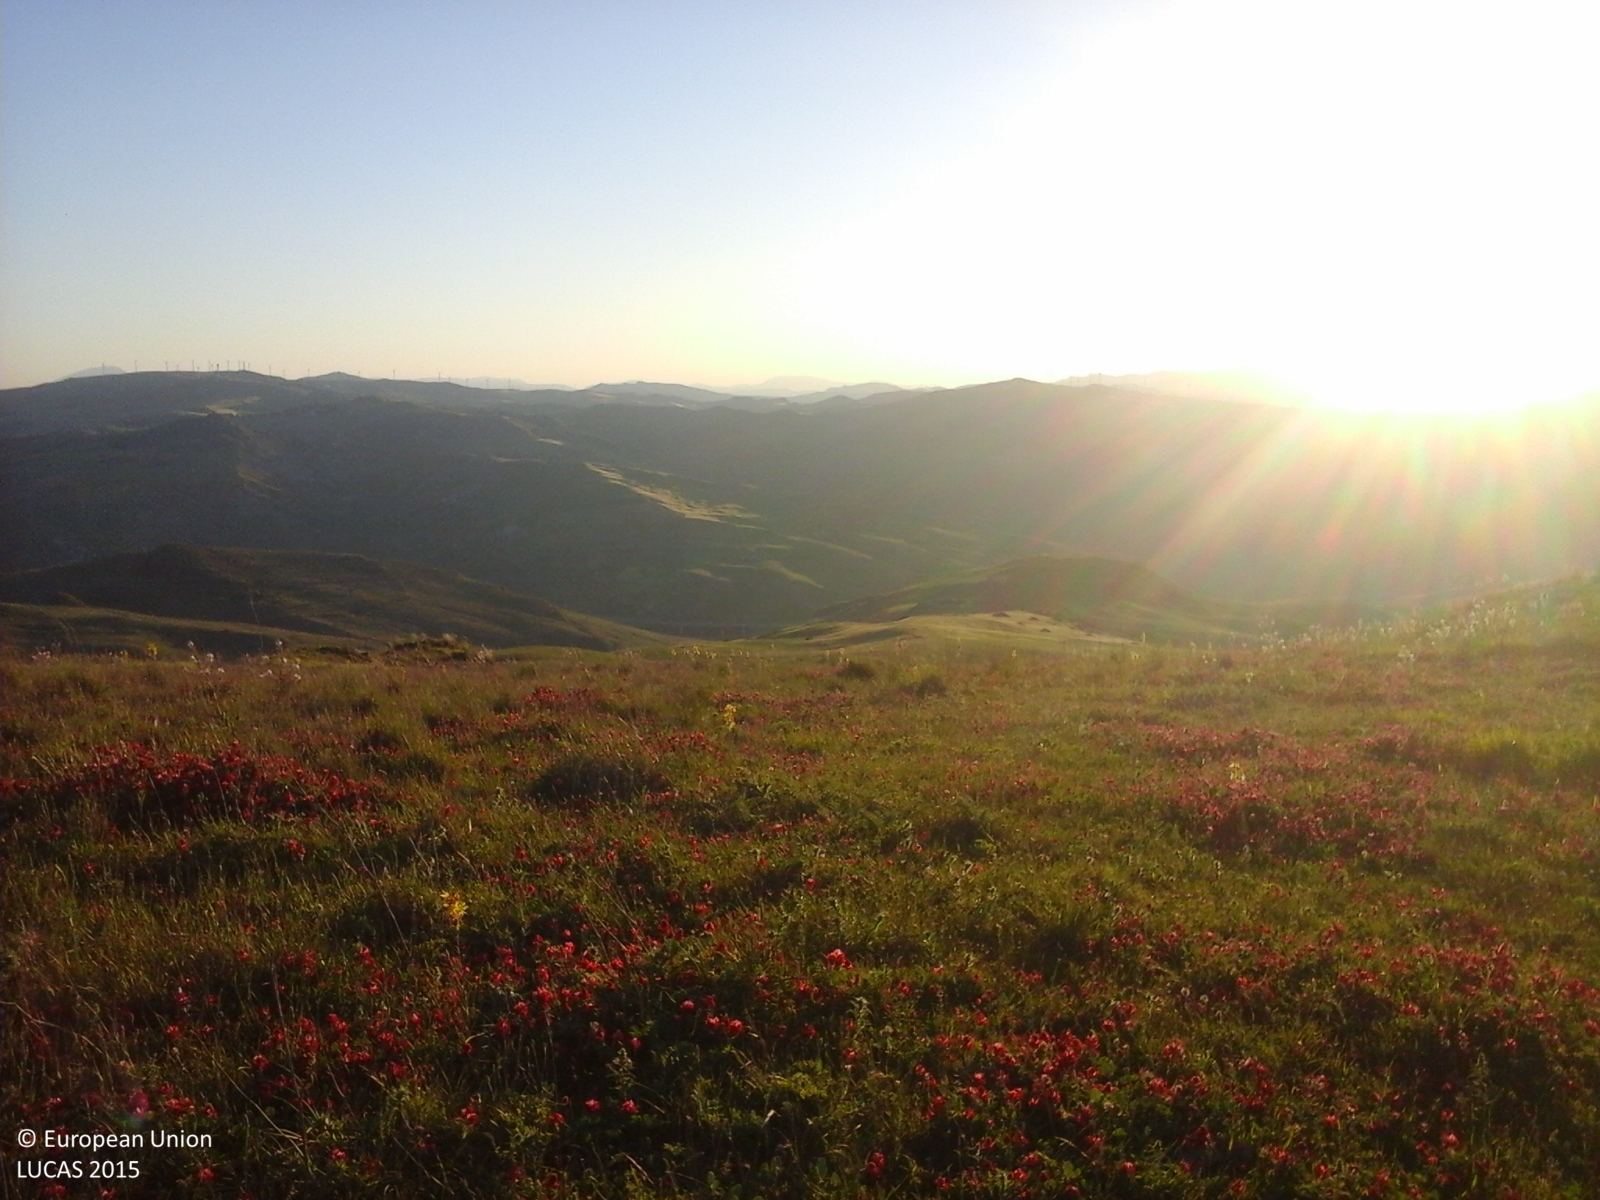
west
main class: Grassland
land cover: Grassland without tree/shrub cover
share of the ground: > 75 %
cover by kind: herbaceous plants 100 %
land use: Agriculture (excluding fallow land and kitchen gardens)
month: May
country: IT
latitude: 37.7905
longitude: 14.0025
